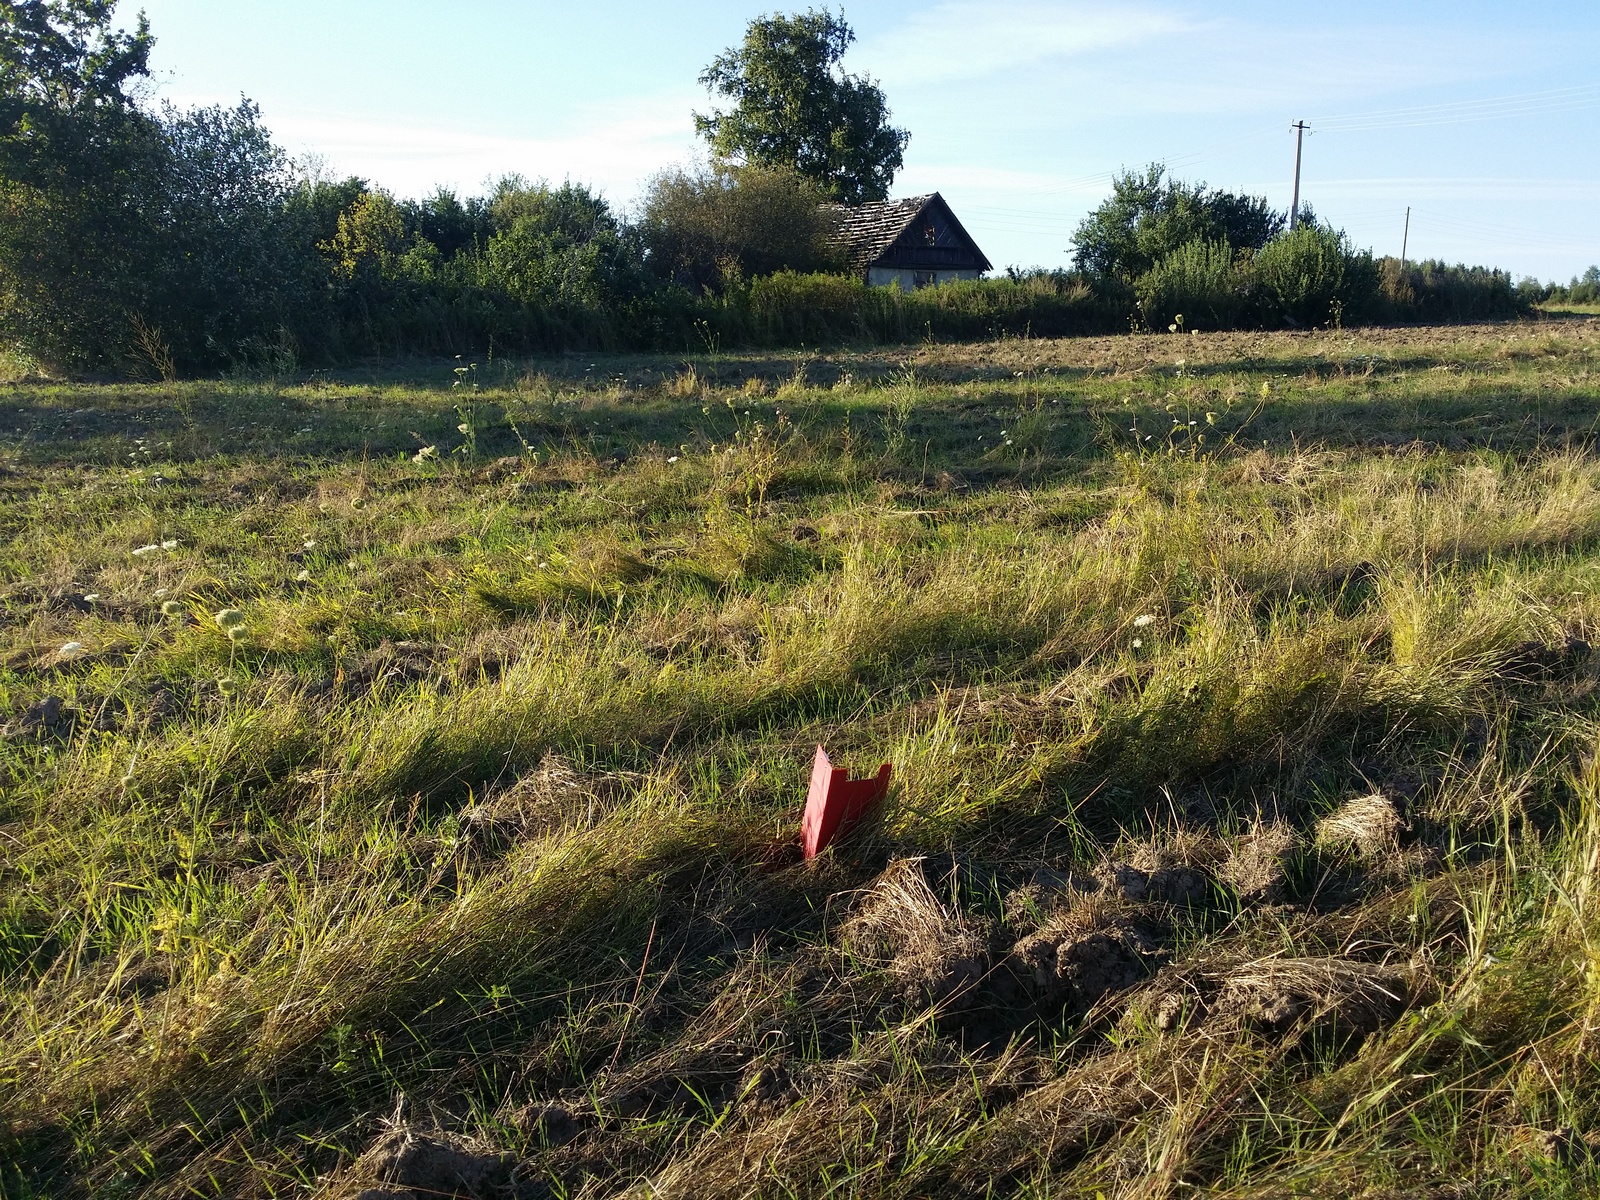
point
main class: Grassland
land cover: Grassland without tree/shrub cover
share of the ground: > 75 %
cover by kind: herbaceous plants 95 %, unconsolidated bare surface 5 %
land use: Agriculture (excluding fallow land and kitchen gardens)
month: August
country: LV
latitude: 57.1253
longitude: 27.6748
